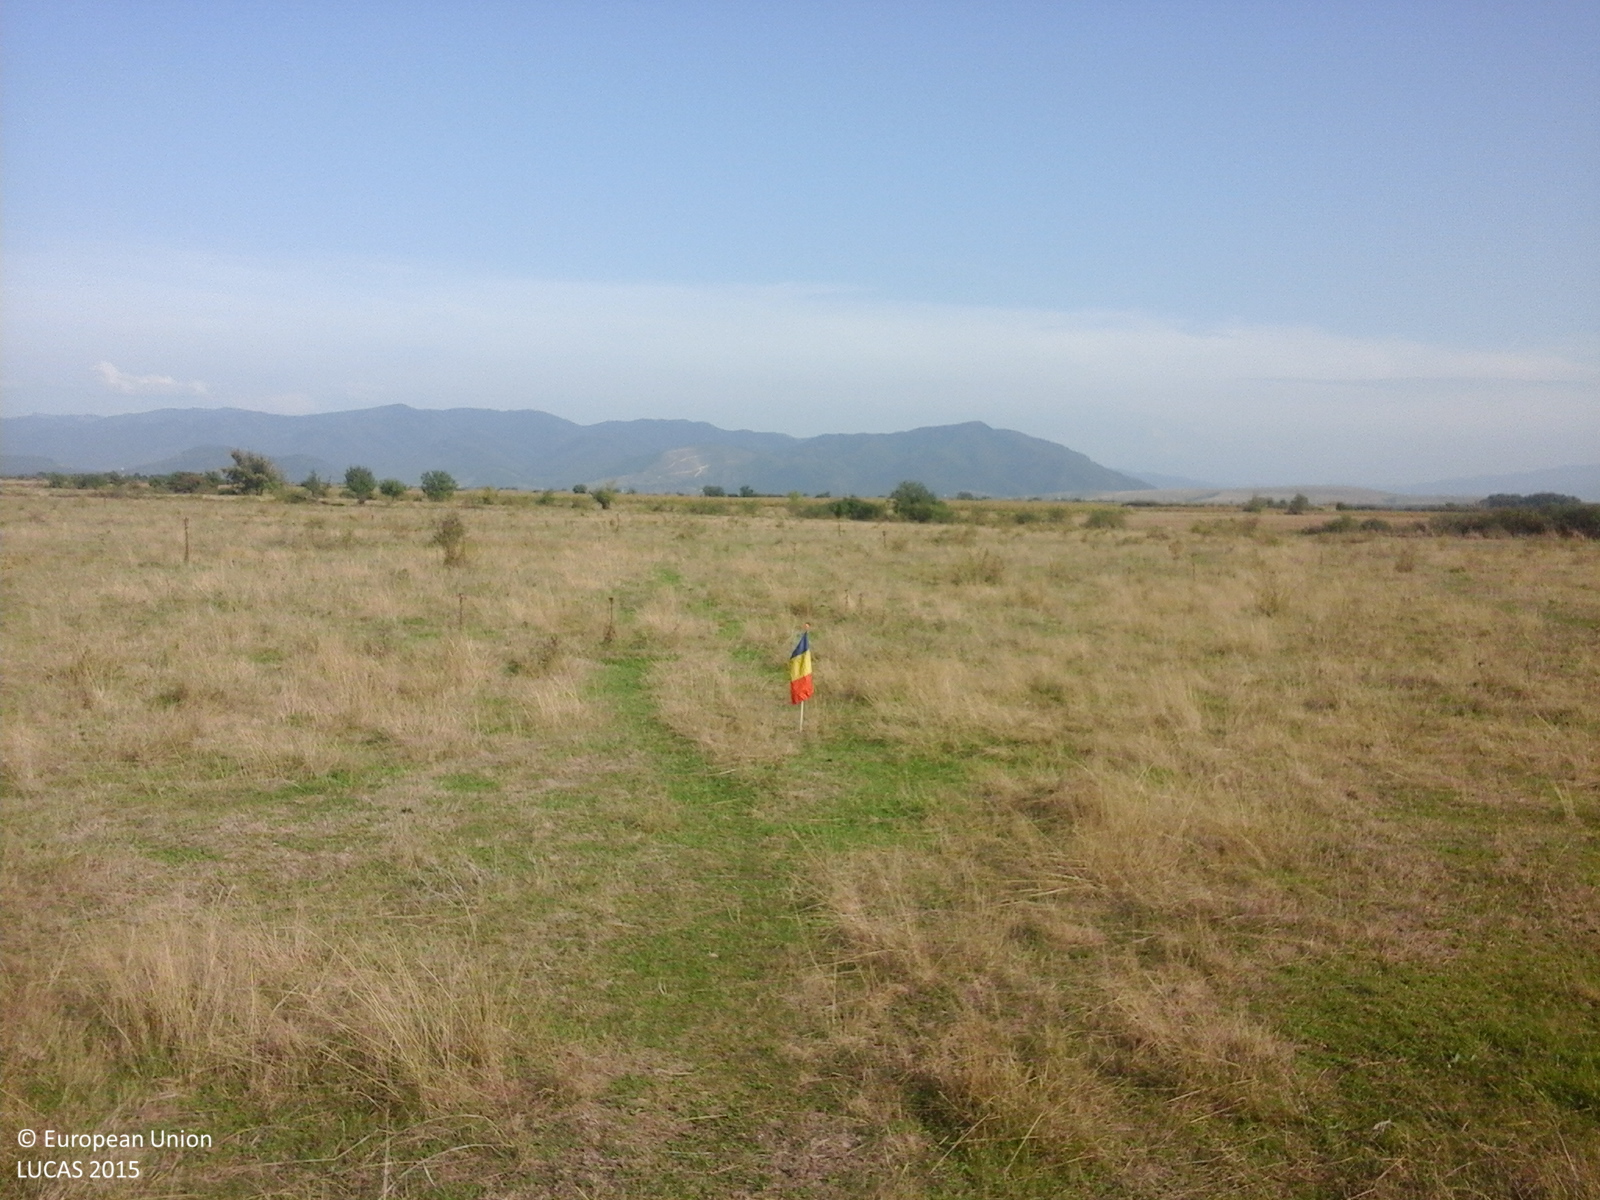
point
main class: Grassland
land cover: Grassland without tree/shrub cover
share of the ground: > 75 %
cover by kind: herbaceous plants 100 %
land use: Agriculture (excluding fallow land and kitchen gardens)
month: September
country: RO
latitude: 45.5867
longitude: 22.8818
